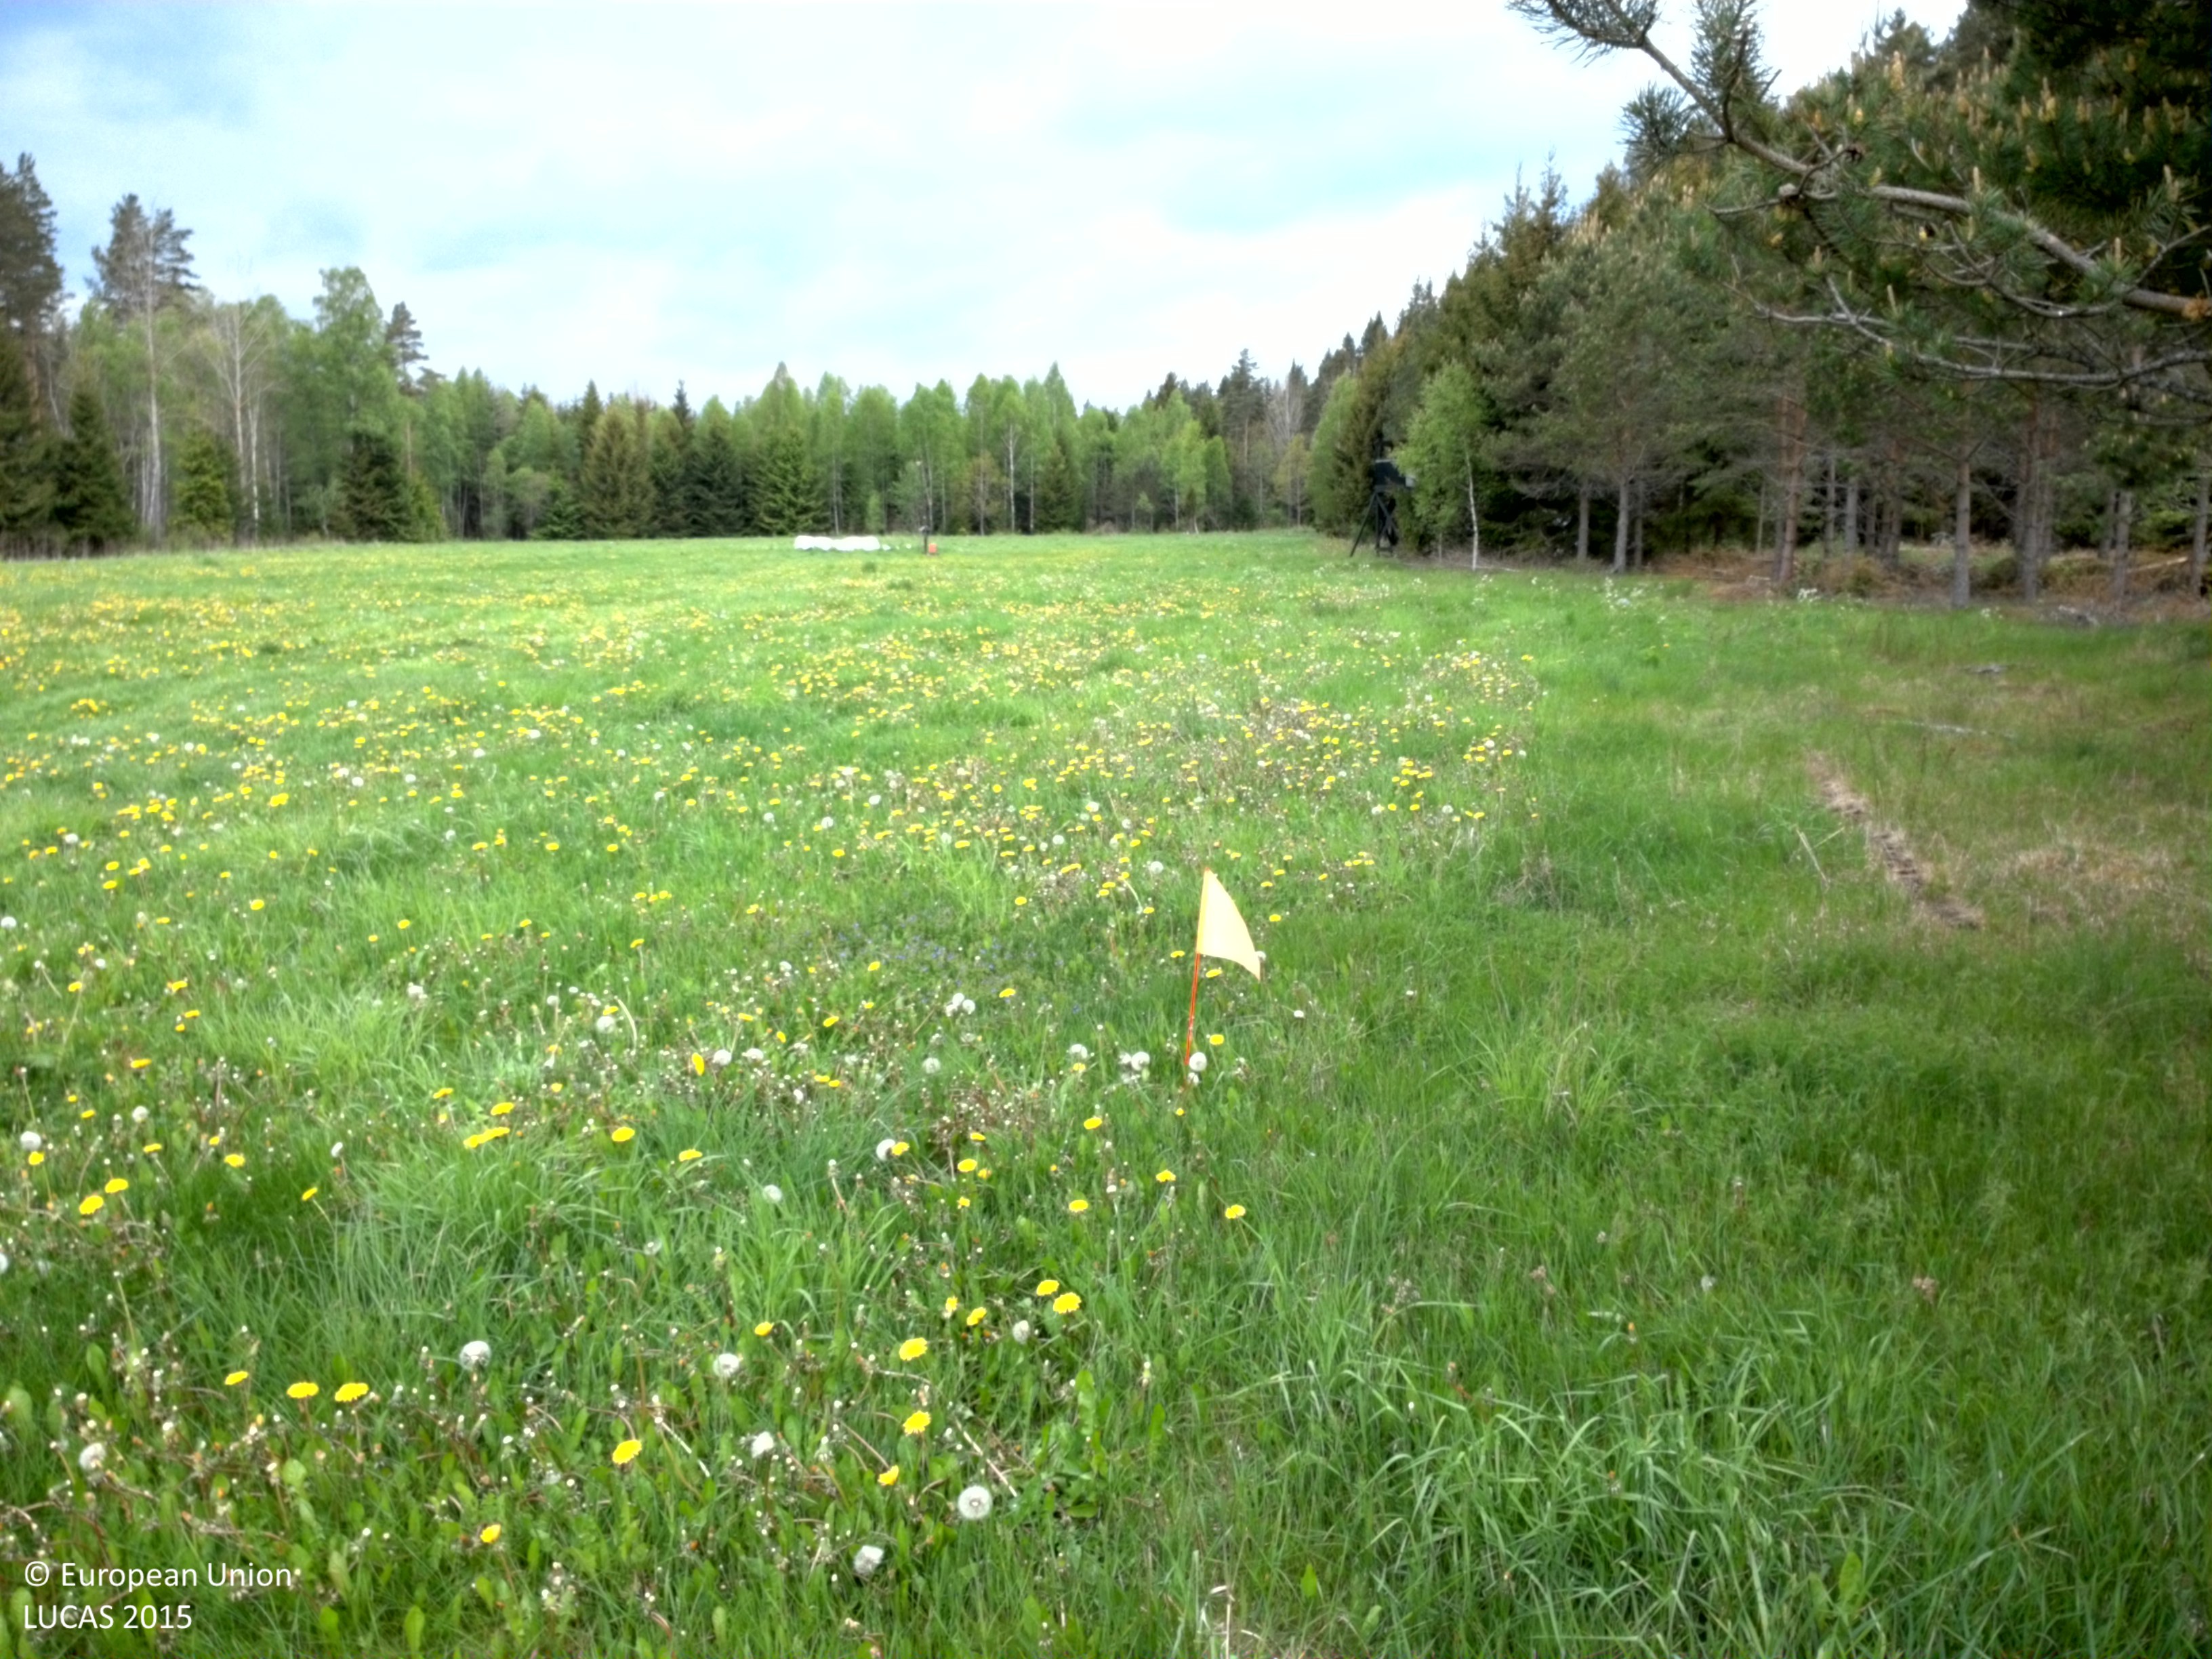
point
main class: Grassland
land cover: Grassland without tree/shrub cover
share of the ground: > 75 %
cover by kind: herbaceous plants 100 %
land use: Agriculture (excluding fallow land and kitchen gardens)
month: May
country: SE
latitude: 57.4242
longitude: 15.4423
